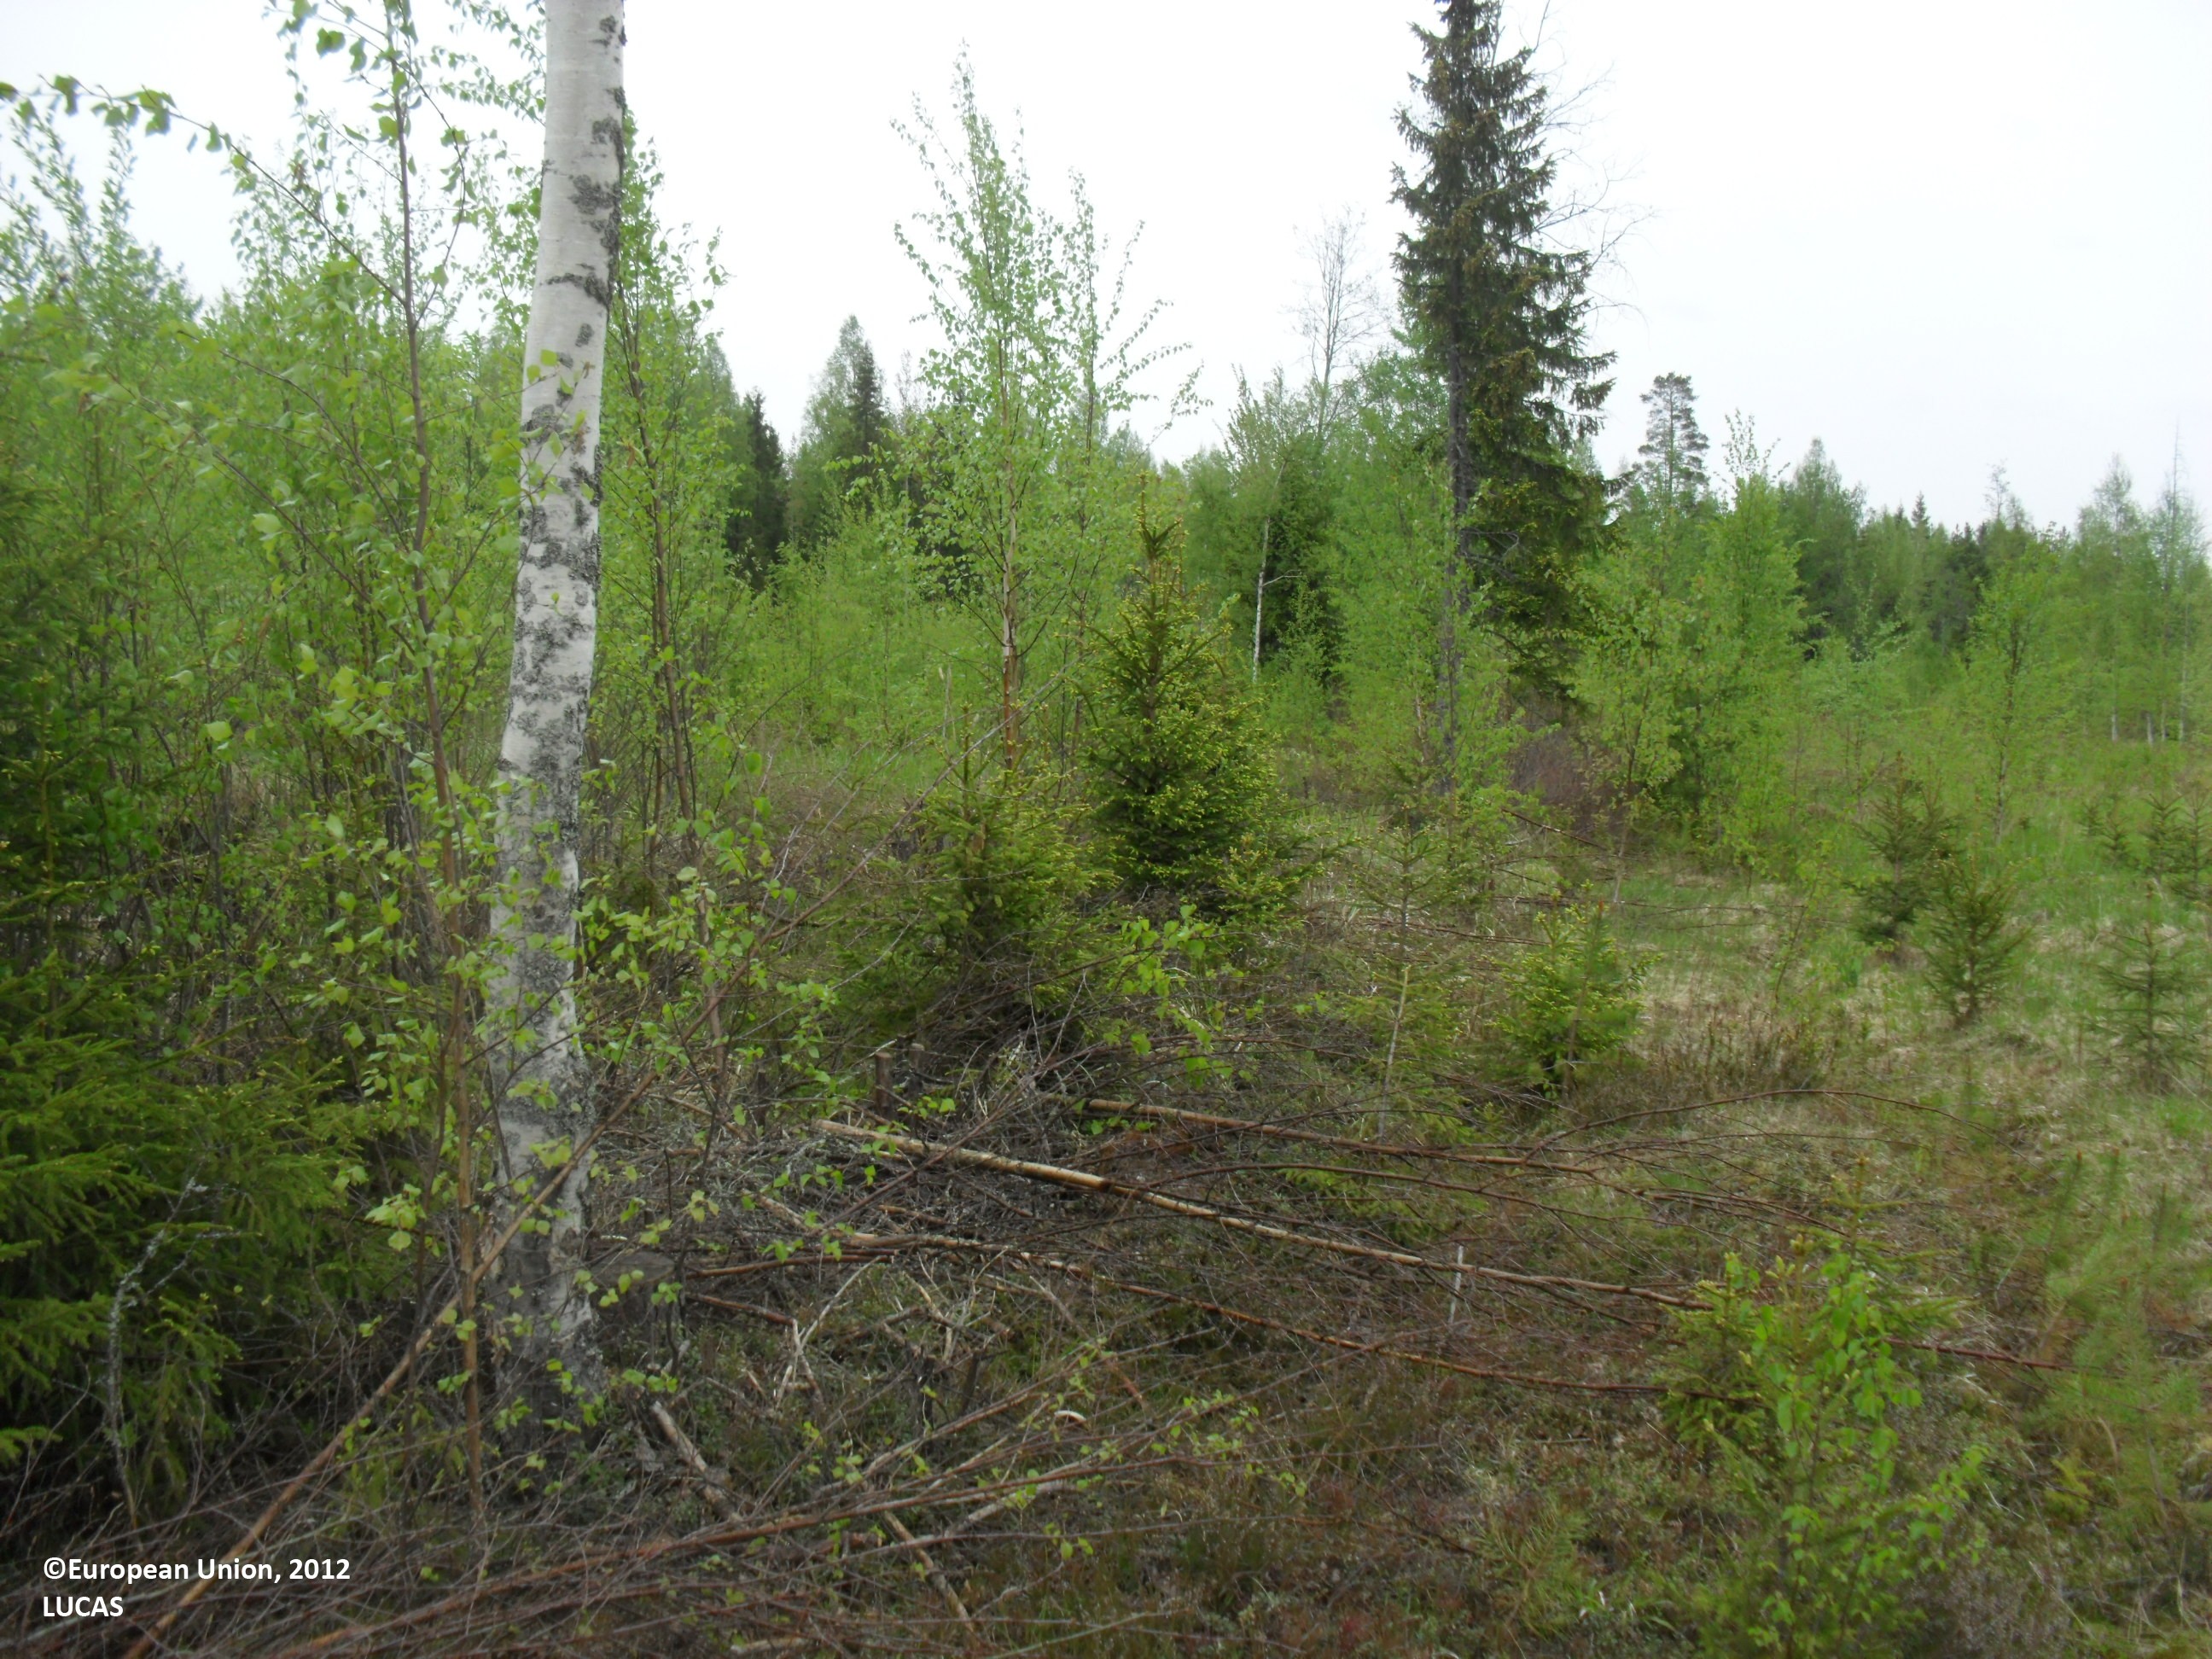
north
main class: Grassland
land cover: Grassland with sparse tree/shrub cover
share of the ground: 10 - 25 %
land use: Semi-natural and natural areas not in use
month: June
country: FI
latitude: 63.0358
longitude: 23.2072
